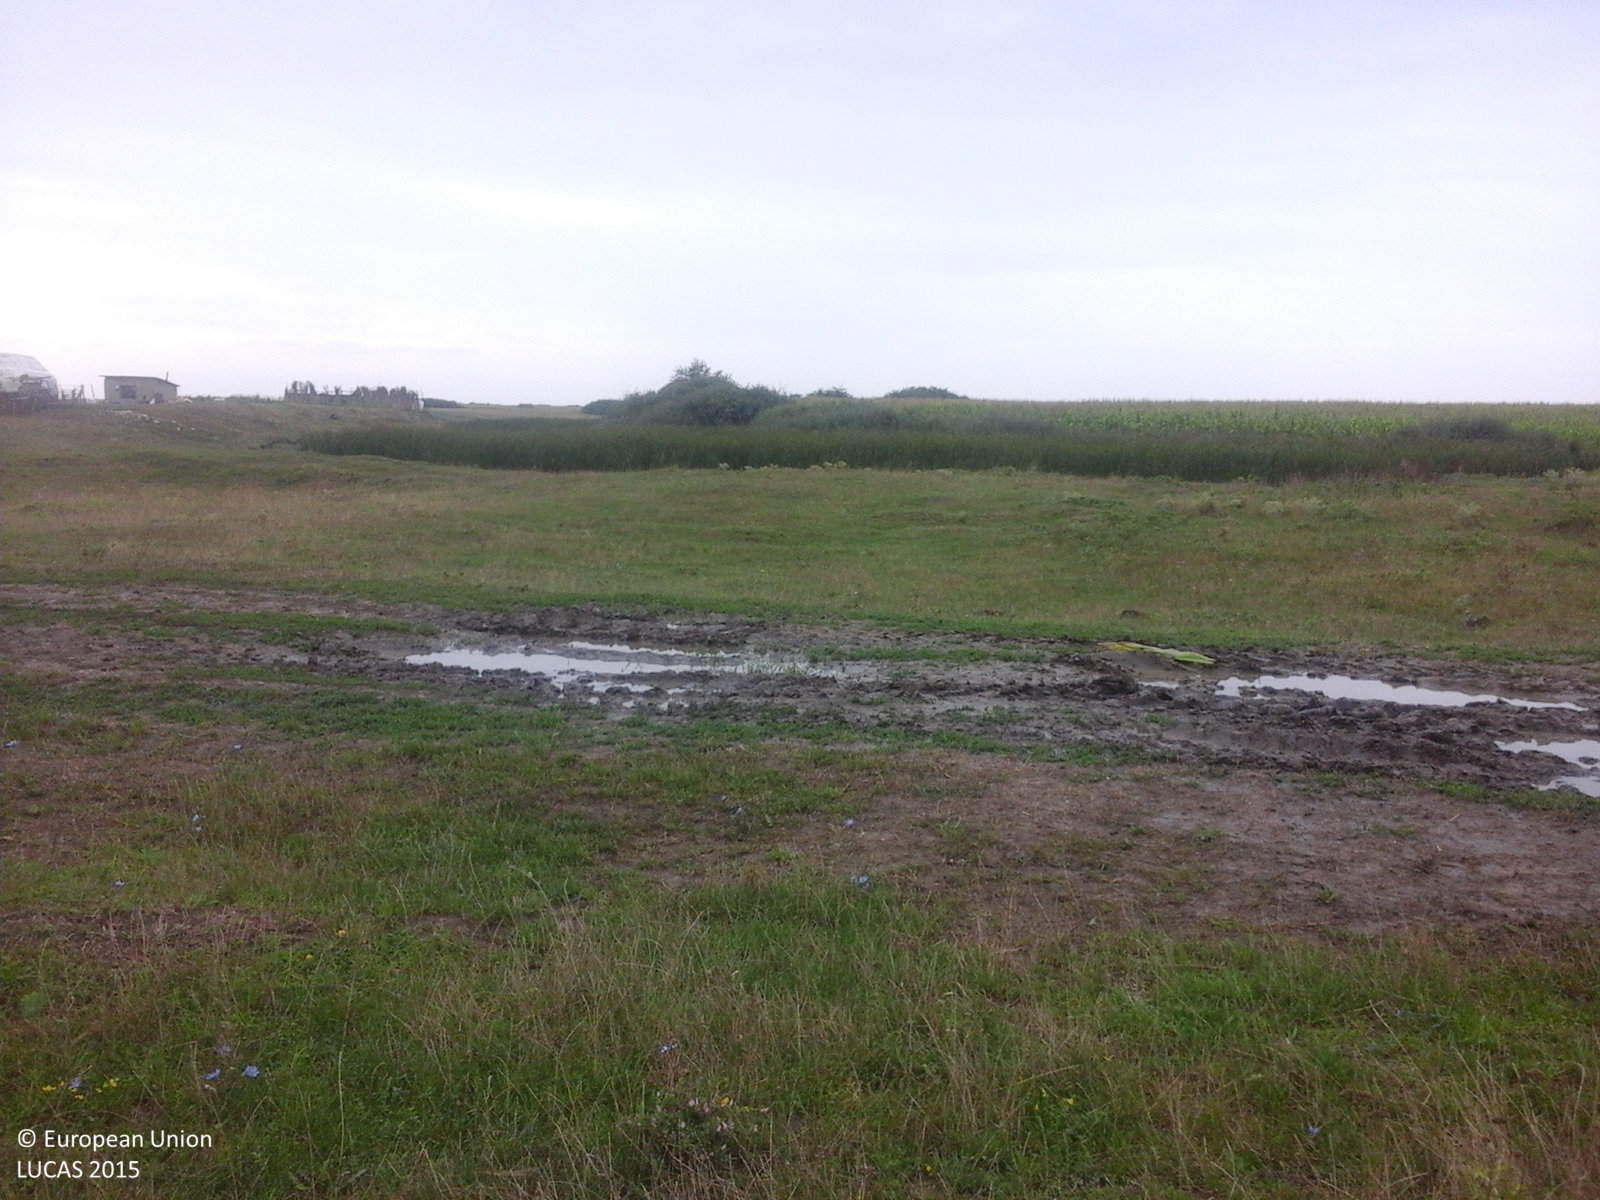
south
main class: Grassland
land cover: Grassland without tree/shrub cover
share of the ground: > 75 %
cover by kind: herbaceous plants 100 %
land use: Agriculture (excluding fallow land and kitchen gardens)
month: August
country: RO
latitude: 45.4057
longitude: 20.9493
